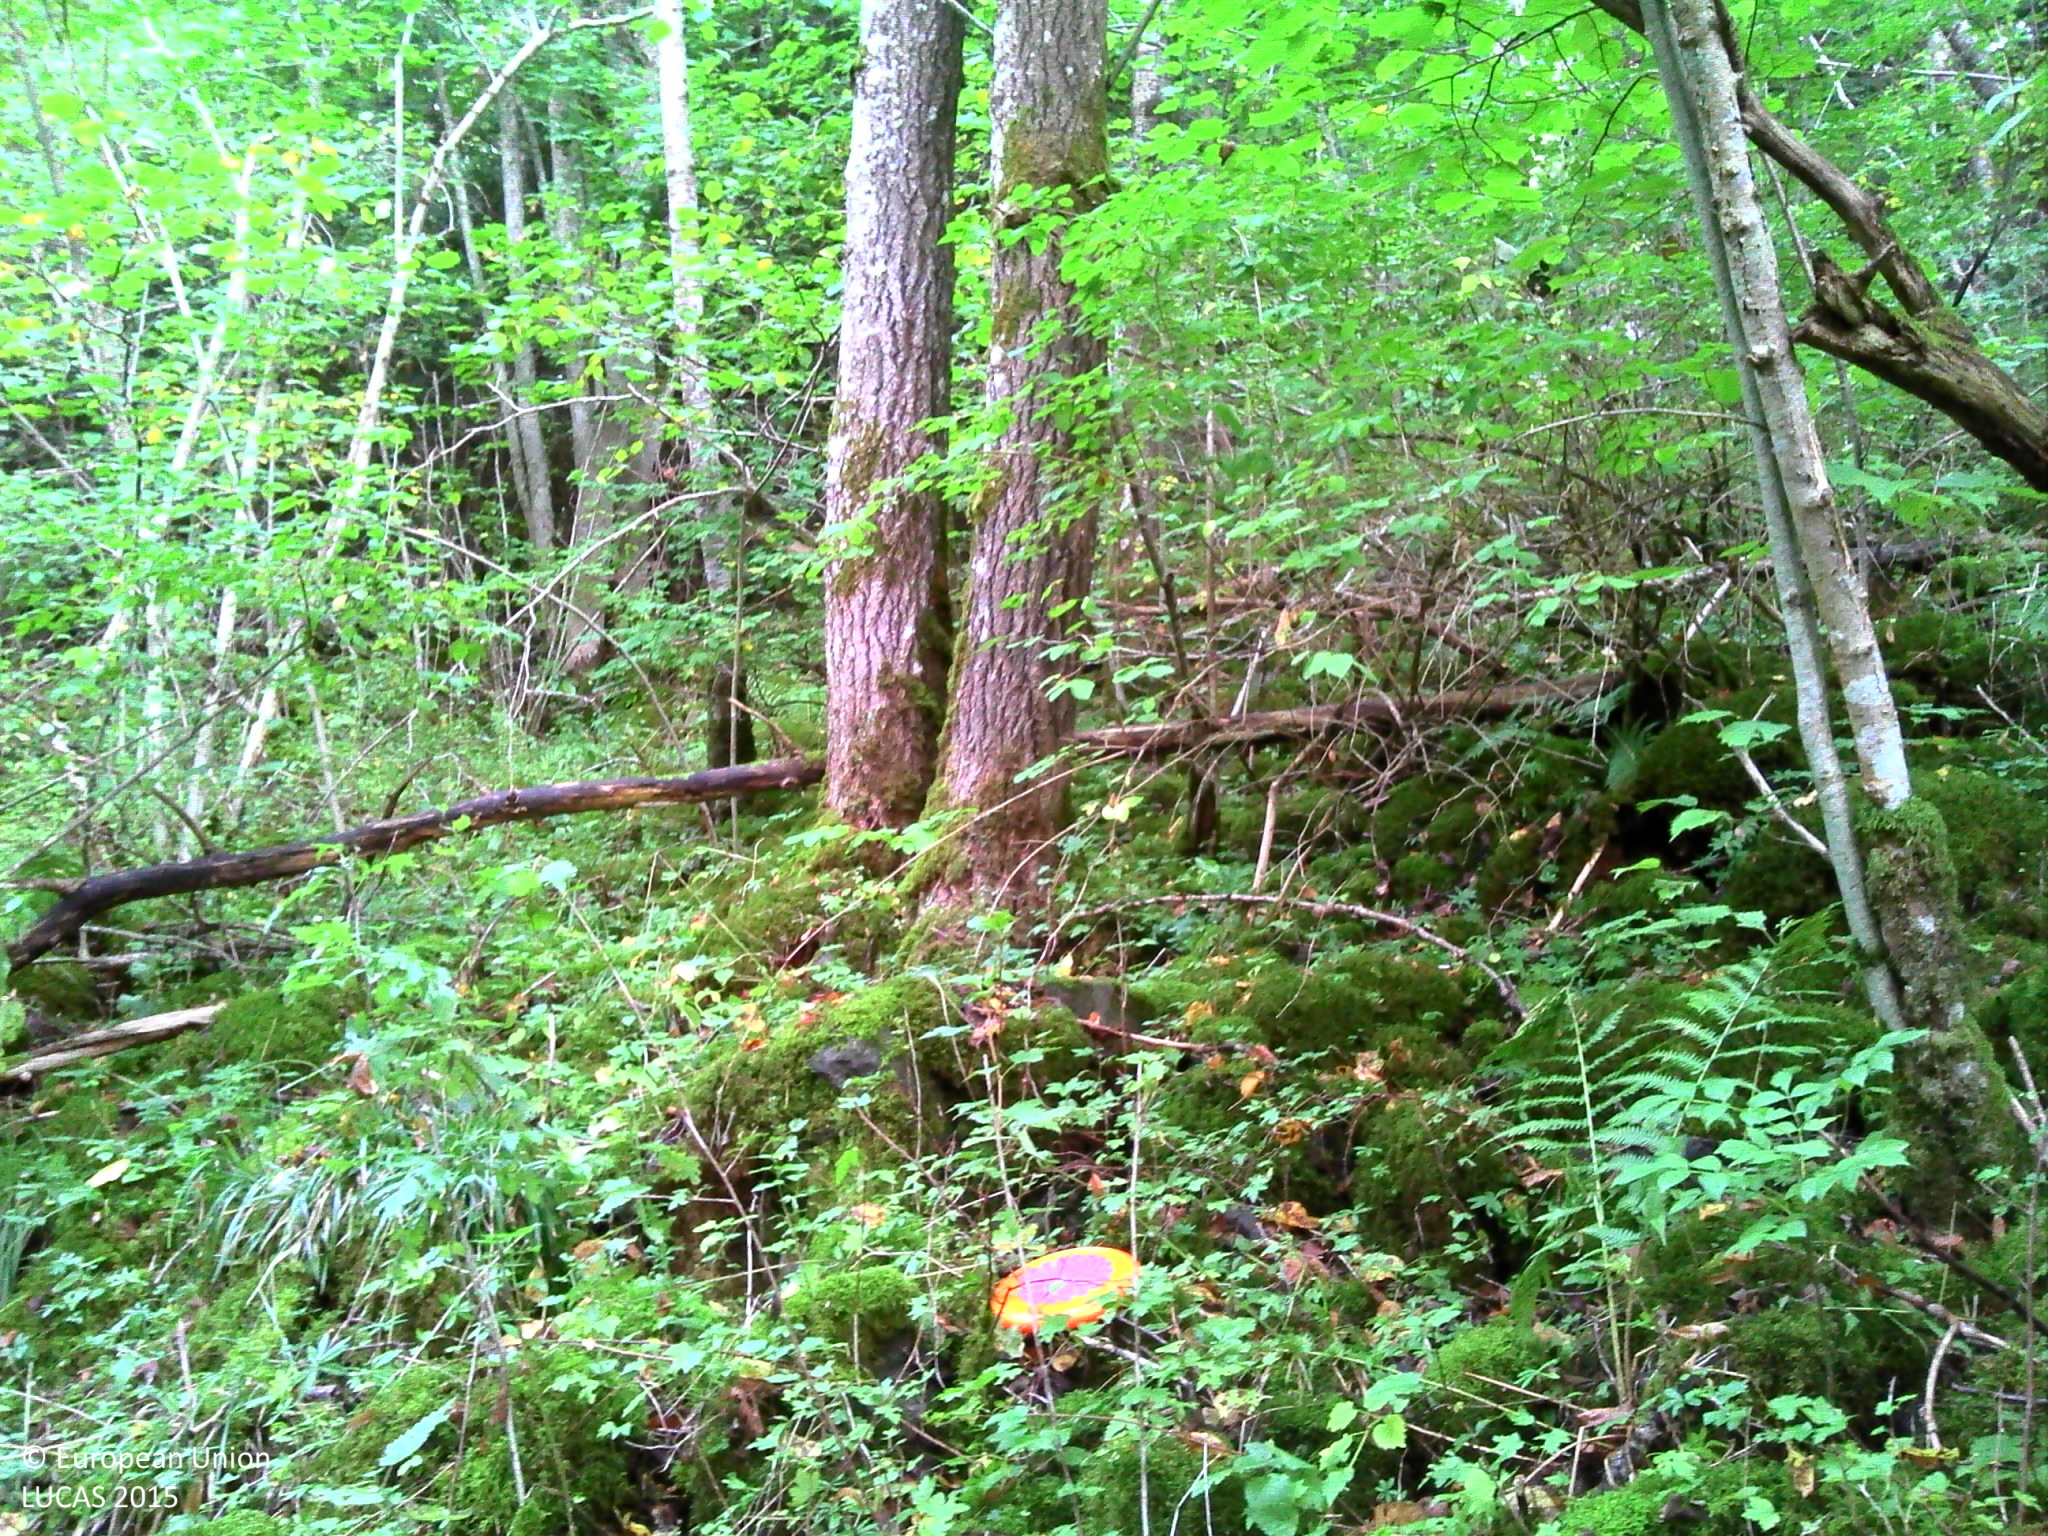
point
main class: Woodland
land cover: Broadleaved woodland
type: mesophytic deciduous forest
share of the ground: > 75 %
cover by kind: broadleaved forest trees 70 %, herbaceous plants 30 %
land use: Forestry
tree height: > 5 m
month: September
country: FR
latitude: 45.8408
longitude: 2.8527
